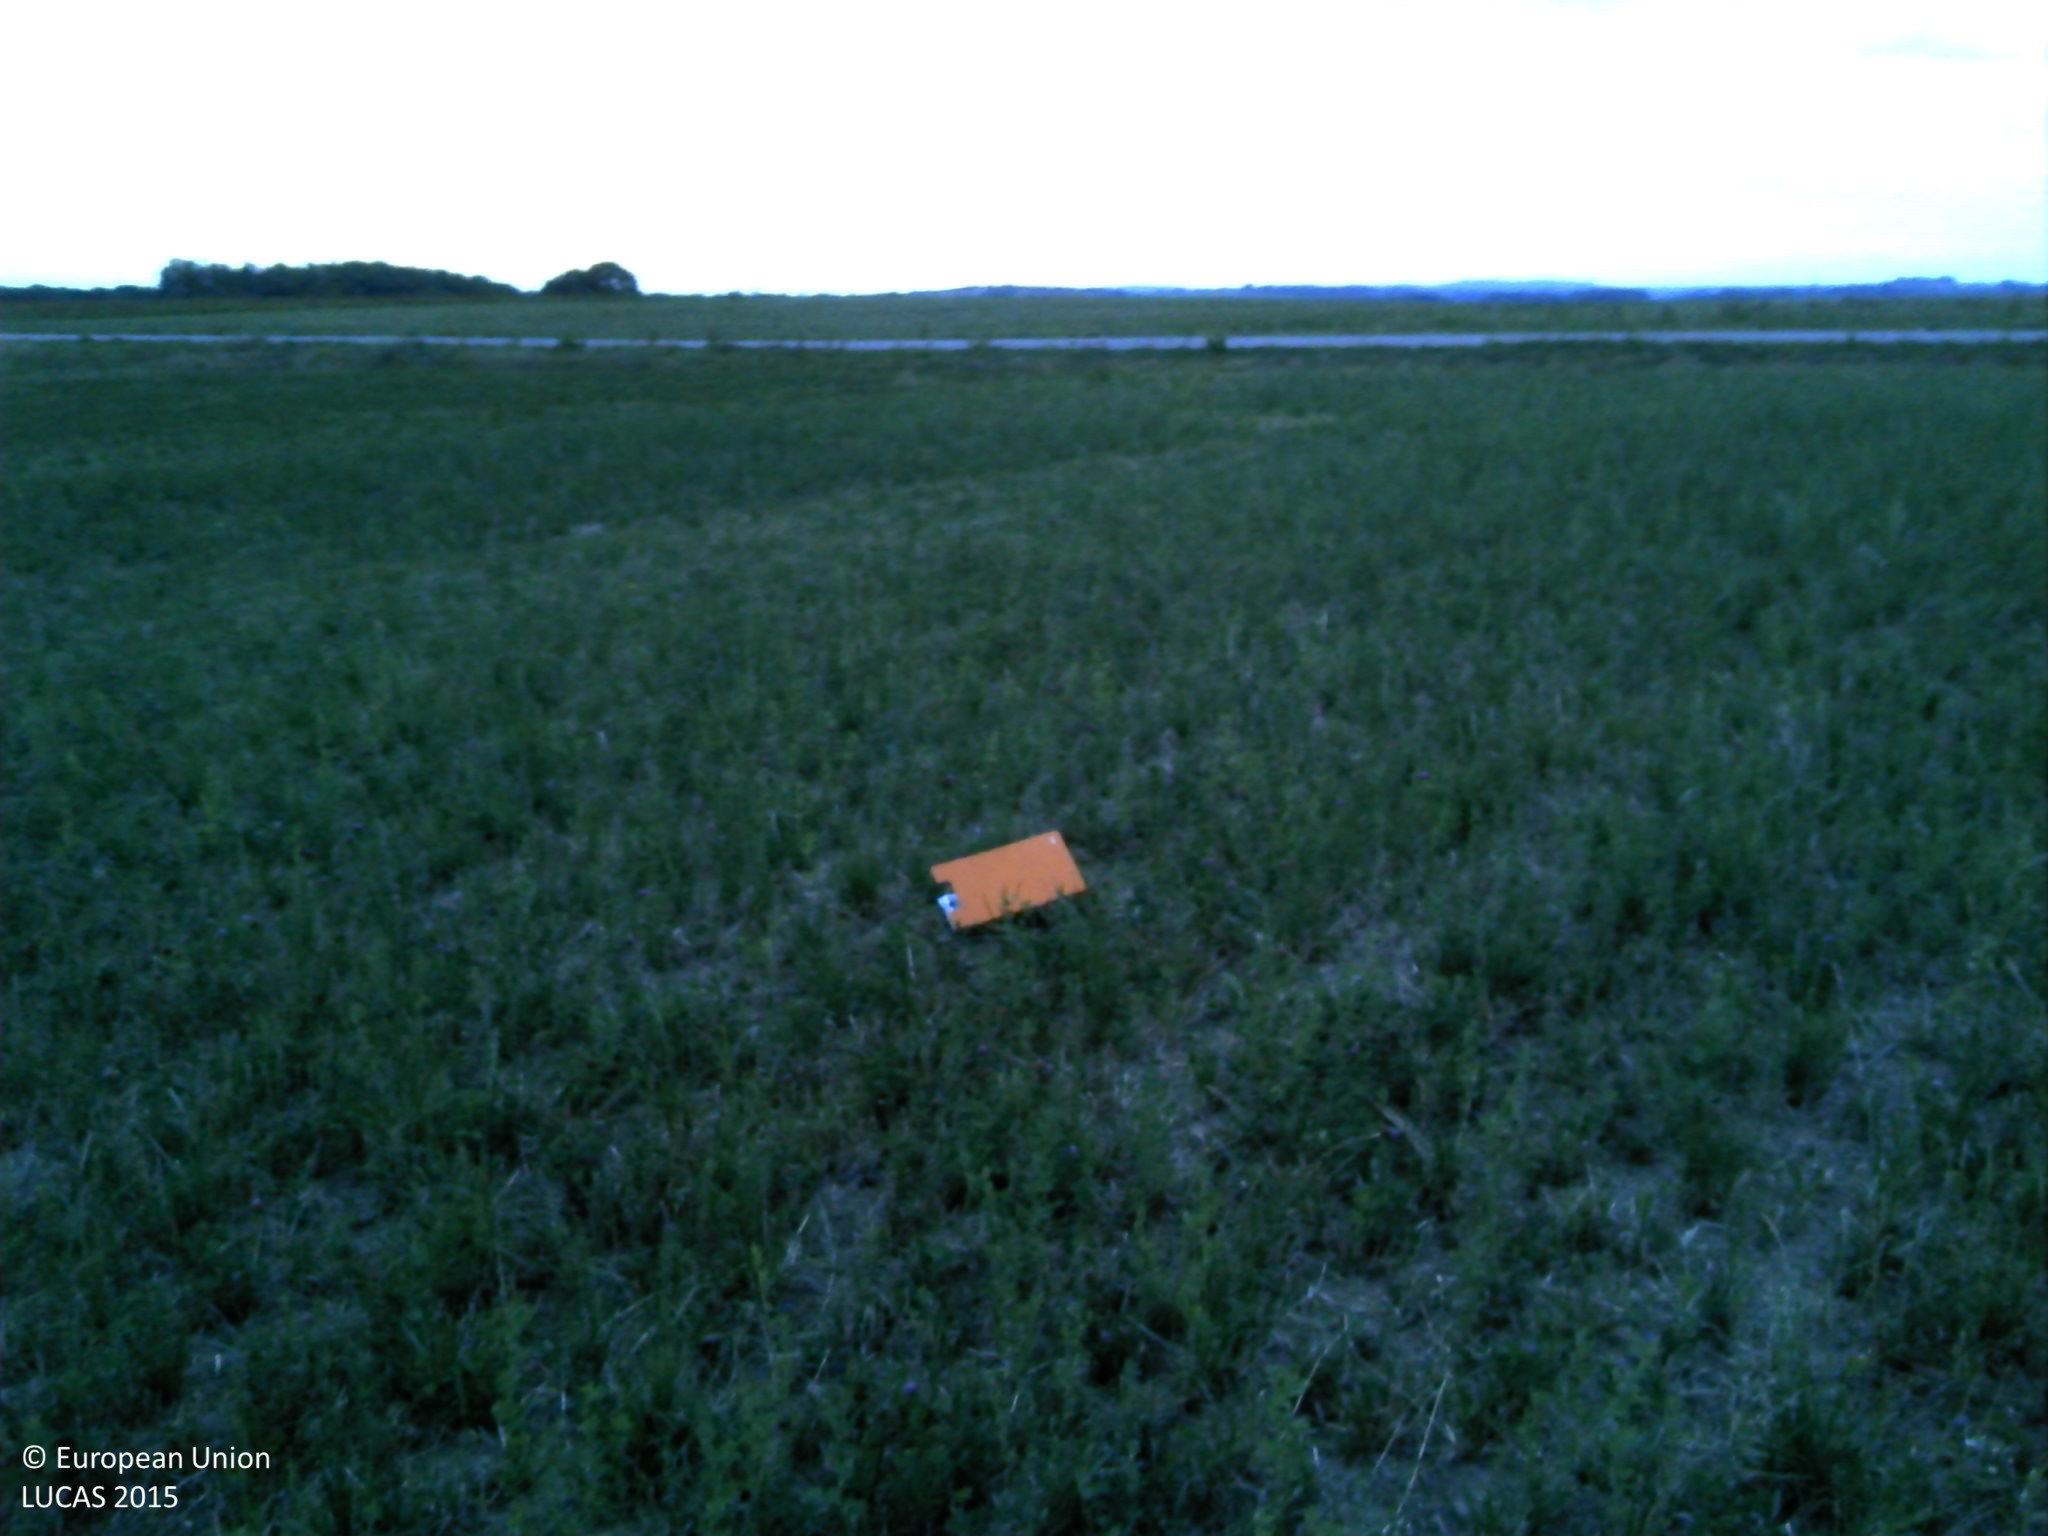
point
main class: Grassland
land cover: Grassland without tree/shrub cover
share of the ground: 50 - 75 %
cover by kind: herbaceous plants 100 %
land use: Agriculture (excluding fallow land and kitchen gardens)
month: August
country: FR
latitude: 48.1238
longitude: 6.2524
